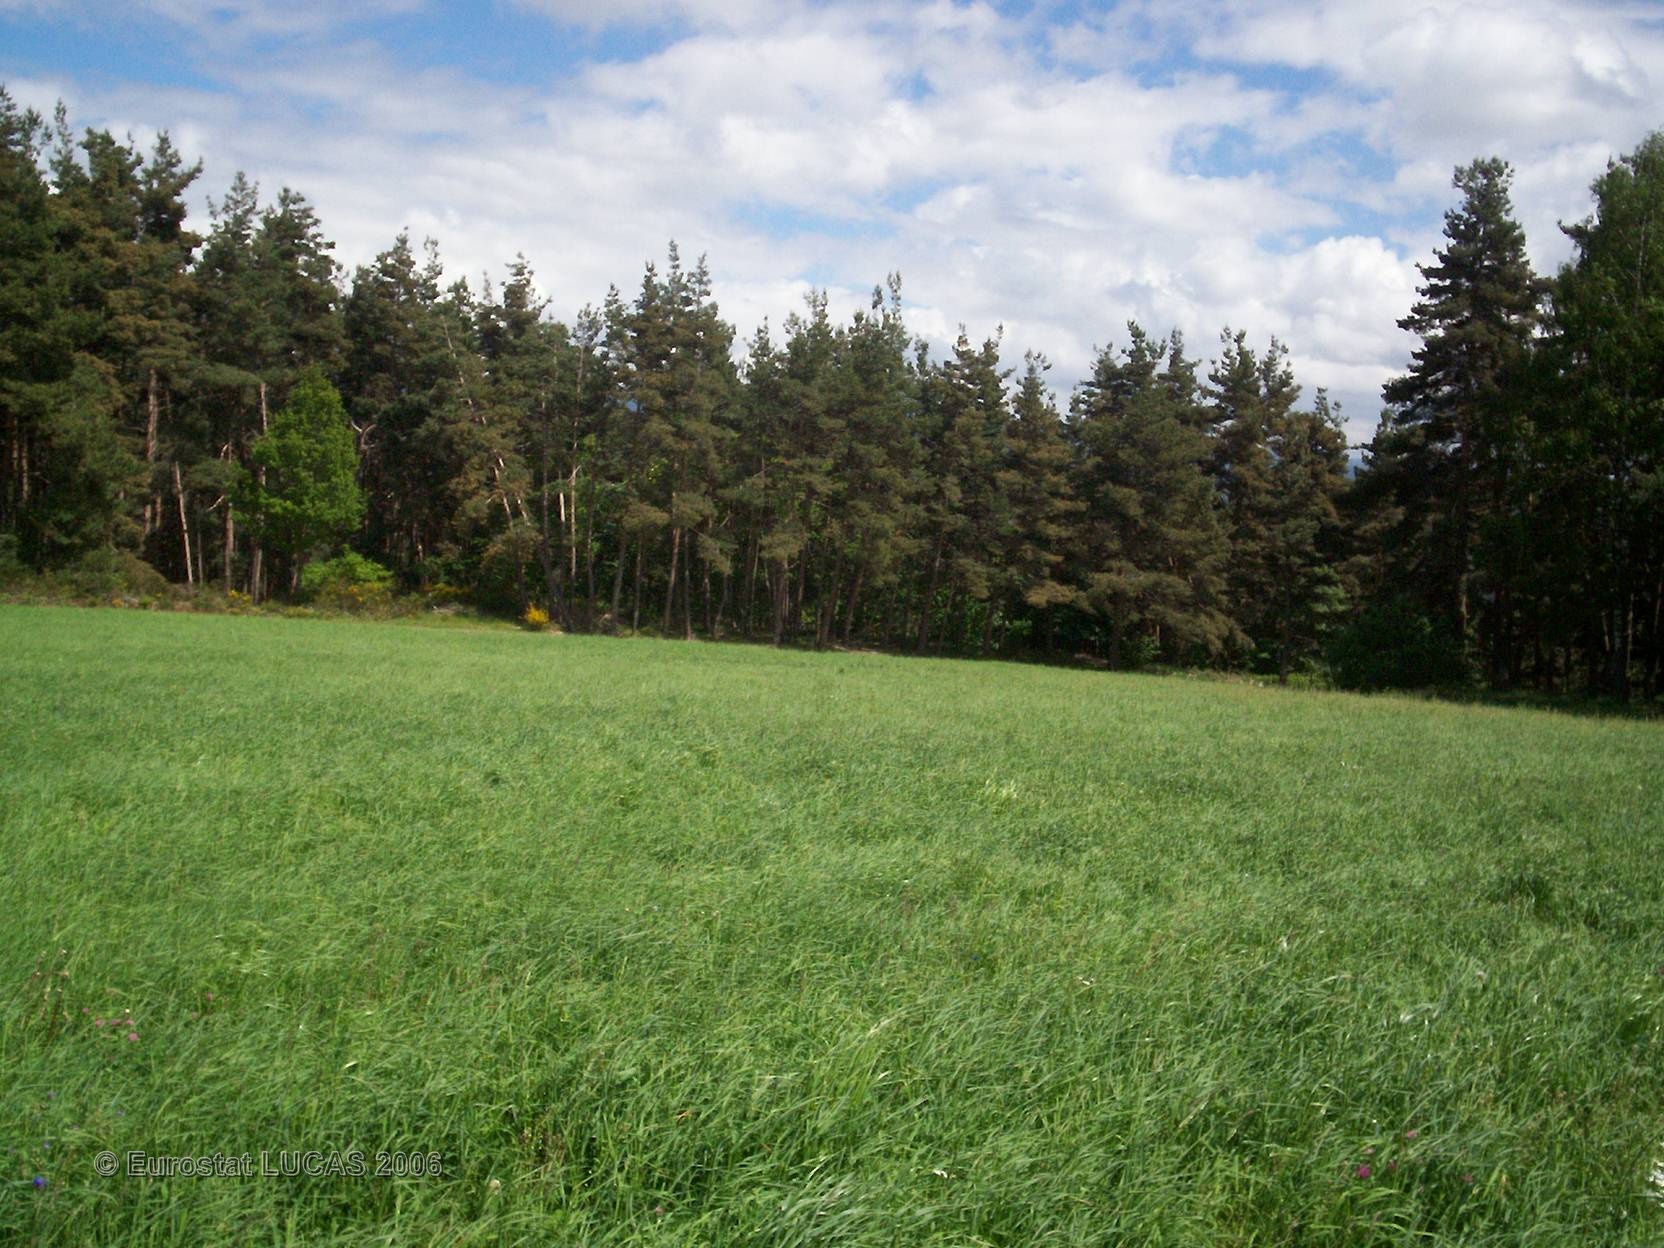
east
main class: Grassland
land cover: Grassland without tree/shrub cover
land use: Agriculture (excluding fallow land and kitchen gardens)
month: May
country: FR
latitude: 44.7879
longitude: 3.3429
